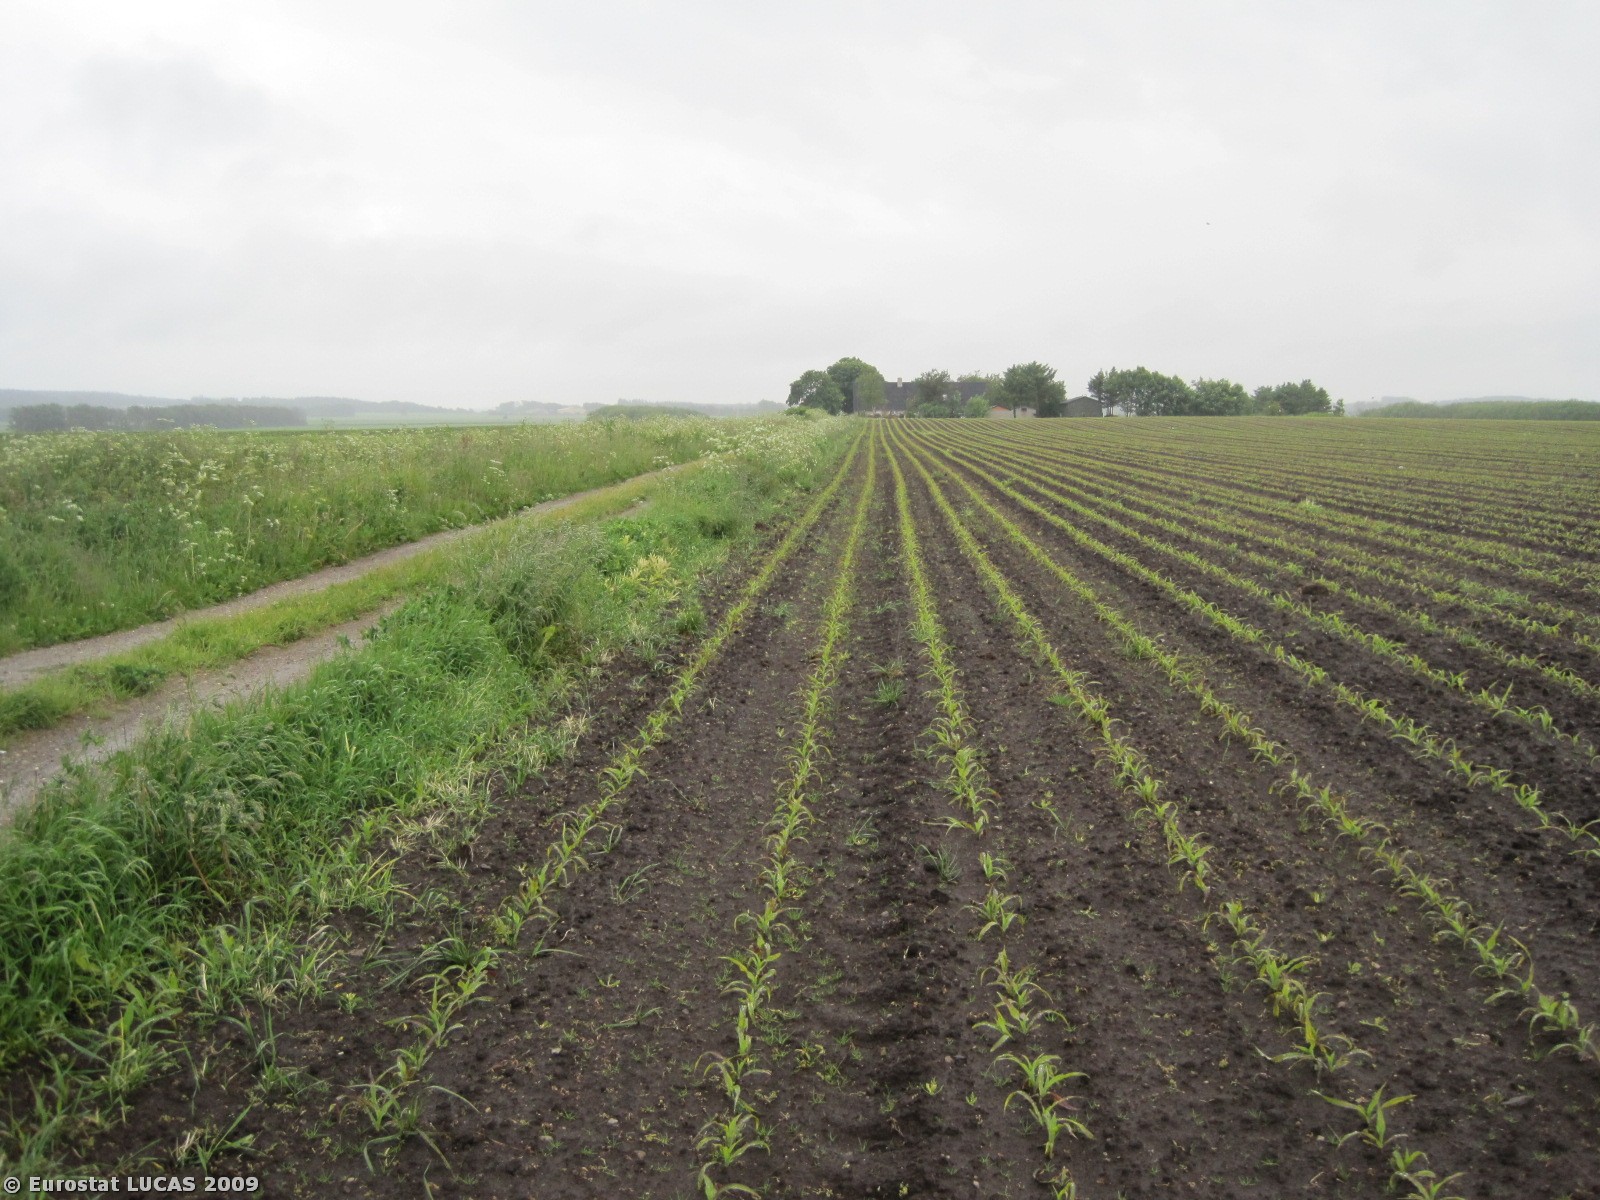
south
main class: Cropland
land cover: Maize
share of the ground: < 10 %
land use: Agriculture (excluding fallow land and kitchen gardens)
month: June
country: DK
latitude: 57.3922
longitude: 10.0831
